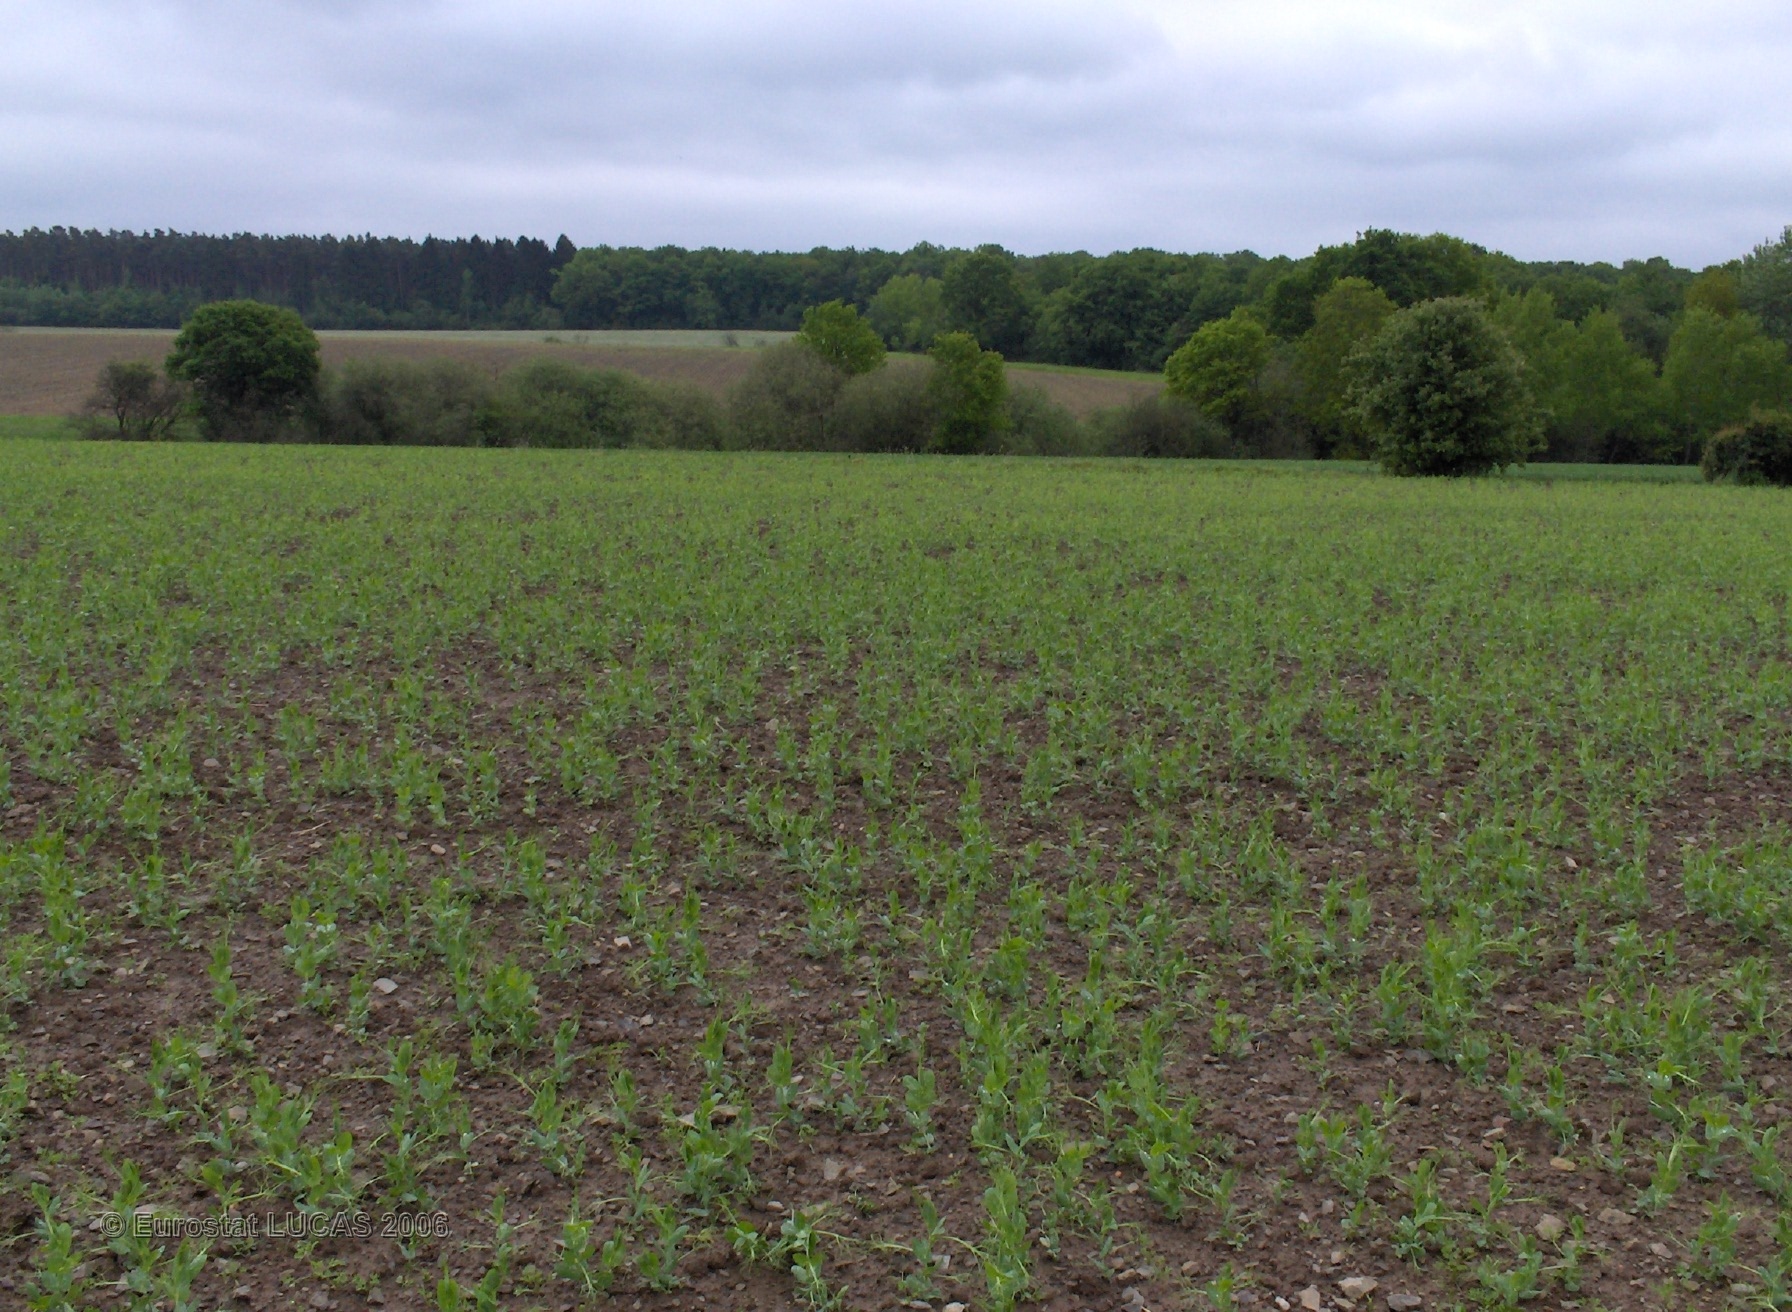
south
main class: Cropland
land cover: Dry pulses
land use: Agriculture (excluding fallow land and kitchen gardens)
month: June
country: BE
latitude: 50.1276
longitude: 4.5827
